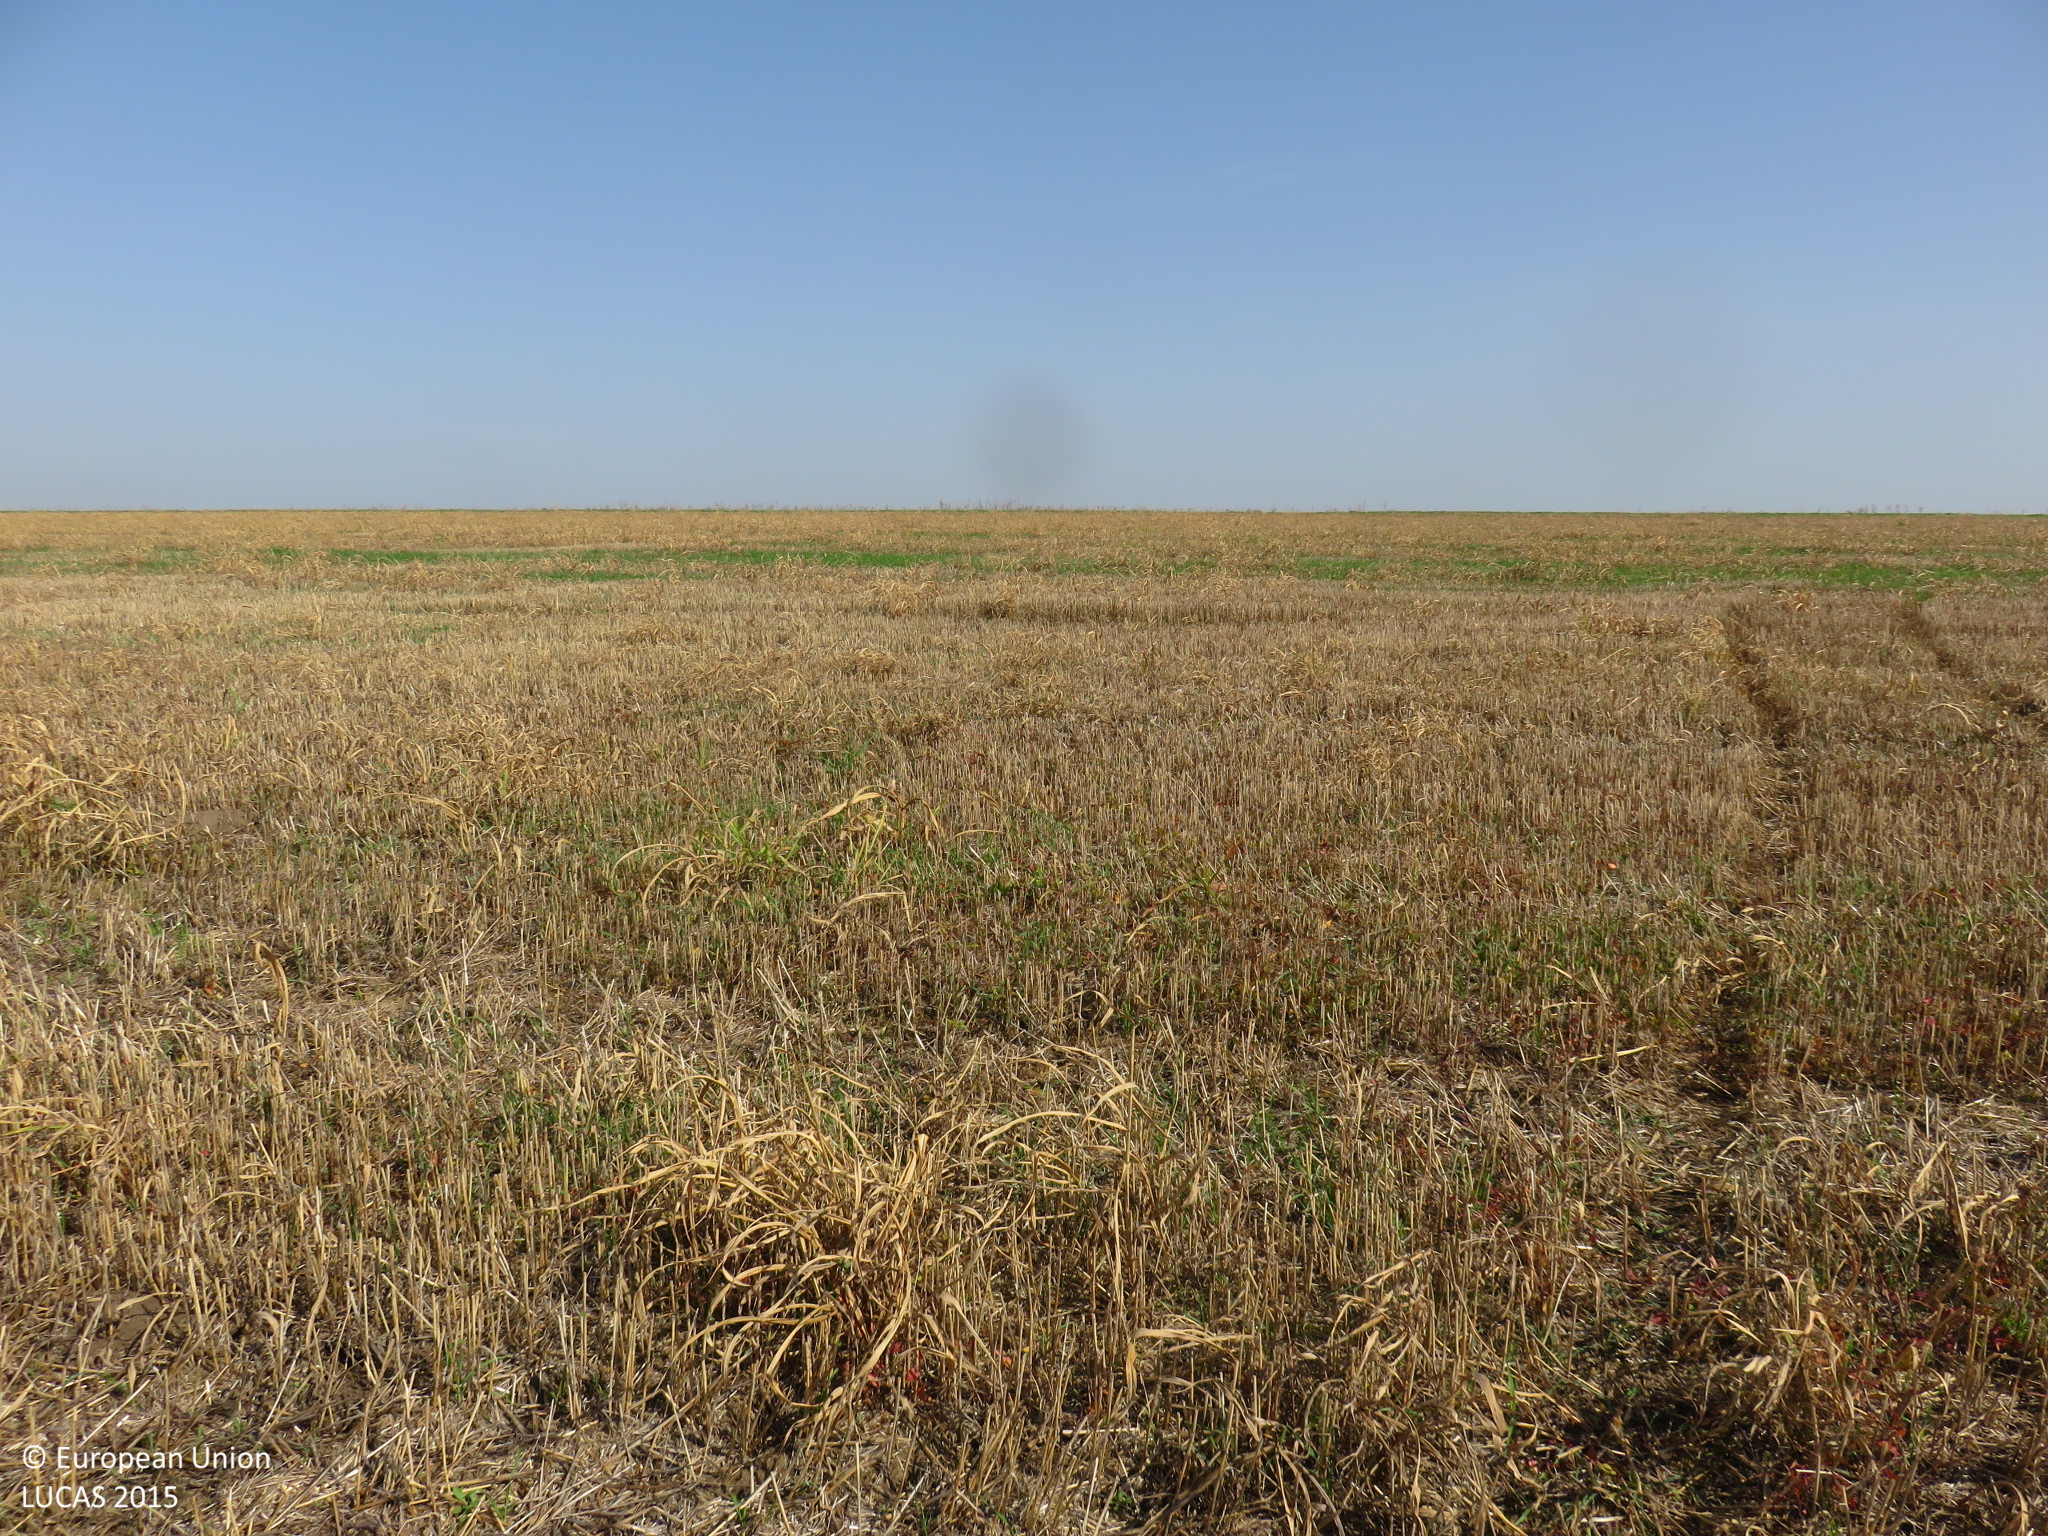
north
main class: Cropland
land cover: Common wheat
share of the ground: > 75 %
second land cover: Spontaneously vegetated surfaces
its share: < 10 %
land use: Agriculture (excluding fallow land and kitchen gardens)
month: September
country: BG
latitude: 43.5941
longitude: 24.5435
